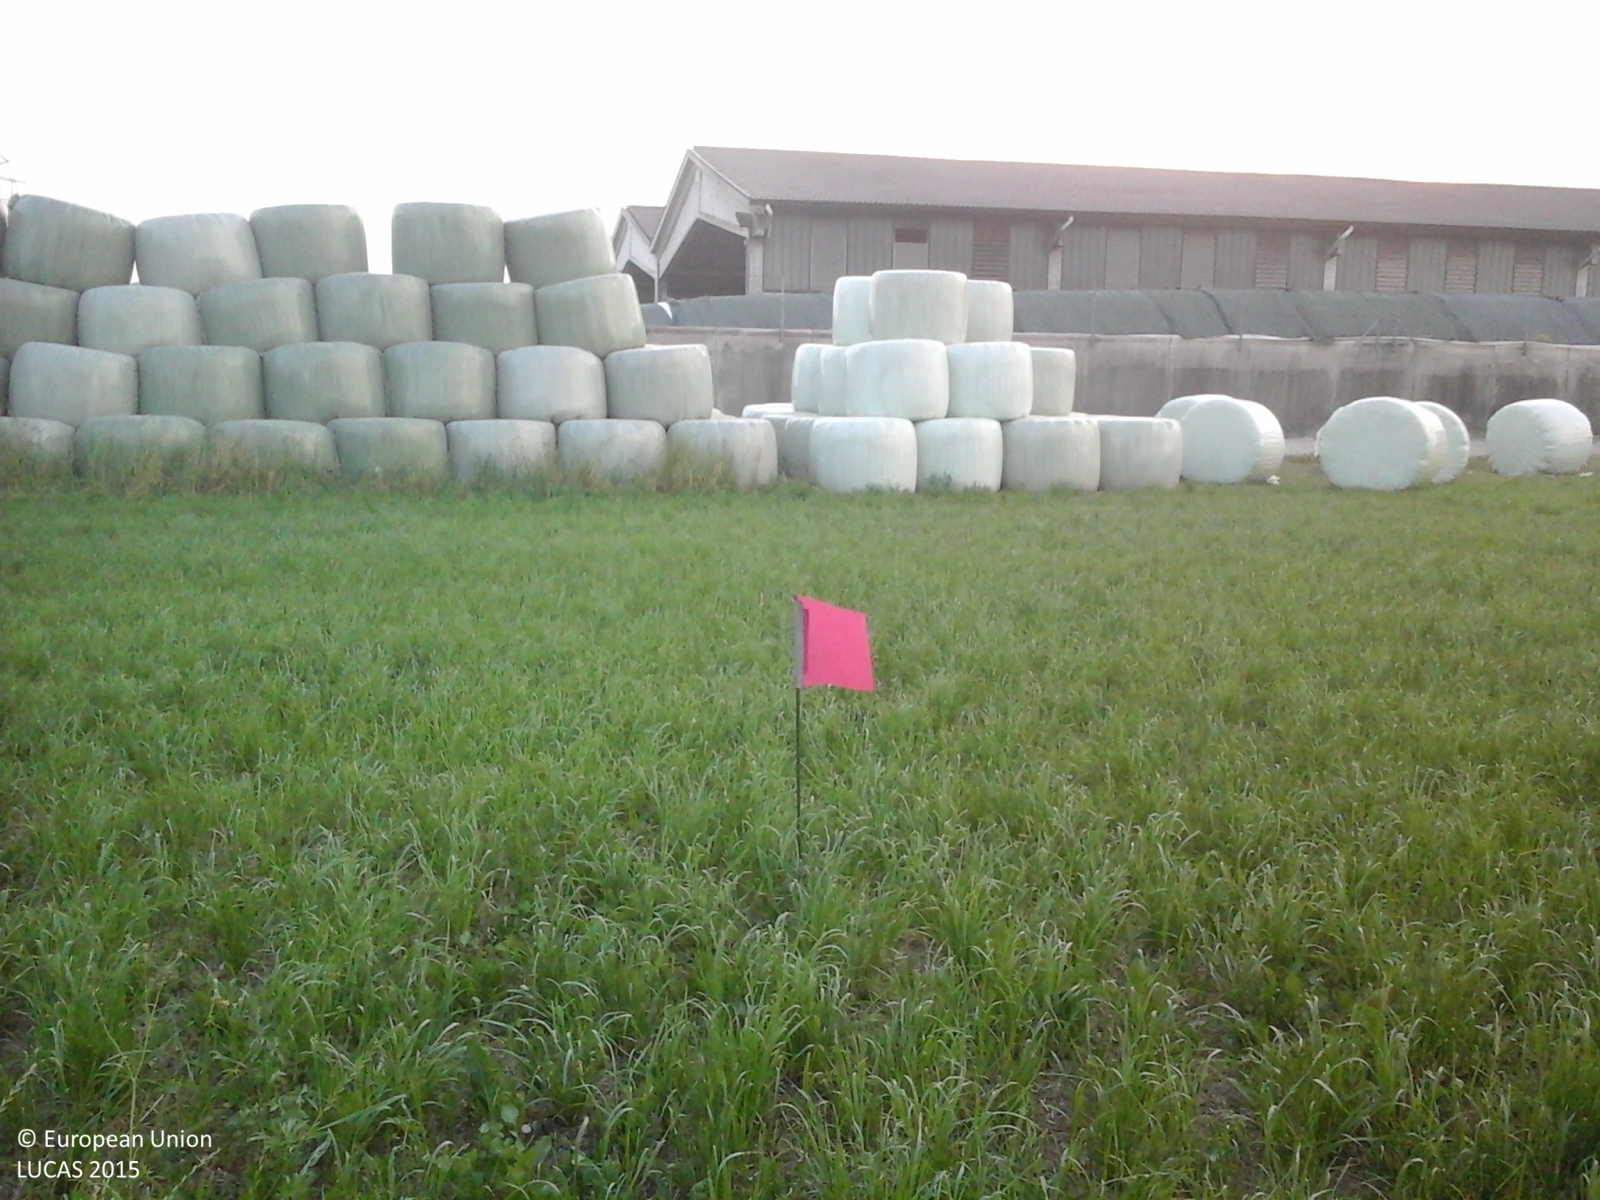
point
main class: Grassland
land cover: Grassland without tree/shrub cover
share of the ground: > 75 %
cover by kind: herbaceous plants 100 %
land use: Agriculture (excluding fallow land and kitchen gardens)
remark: Harvested field
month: May
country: IT
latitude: 45.2133
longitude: 10.7499
